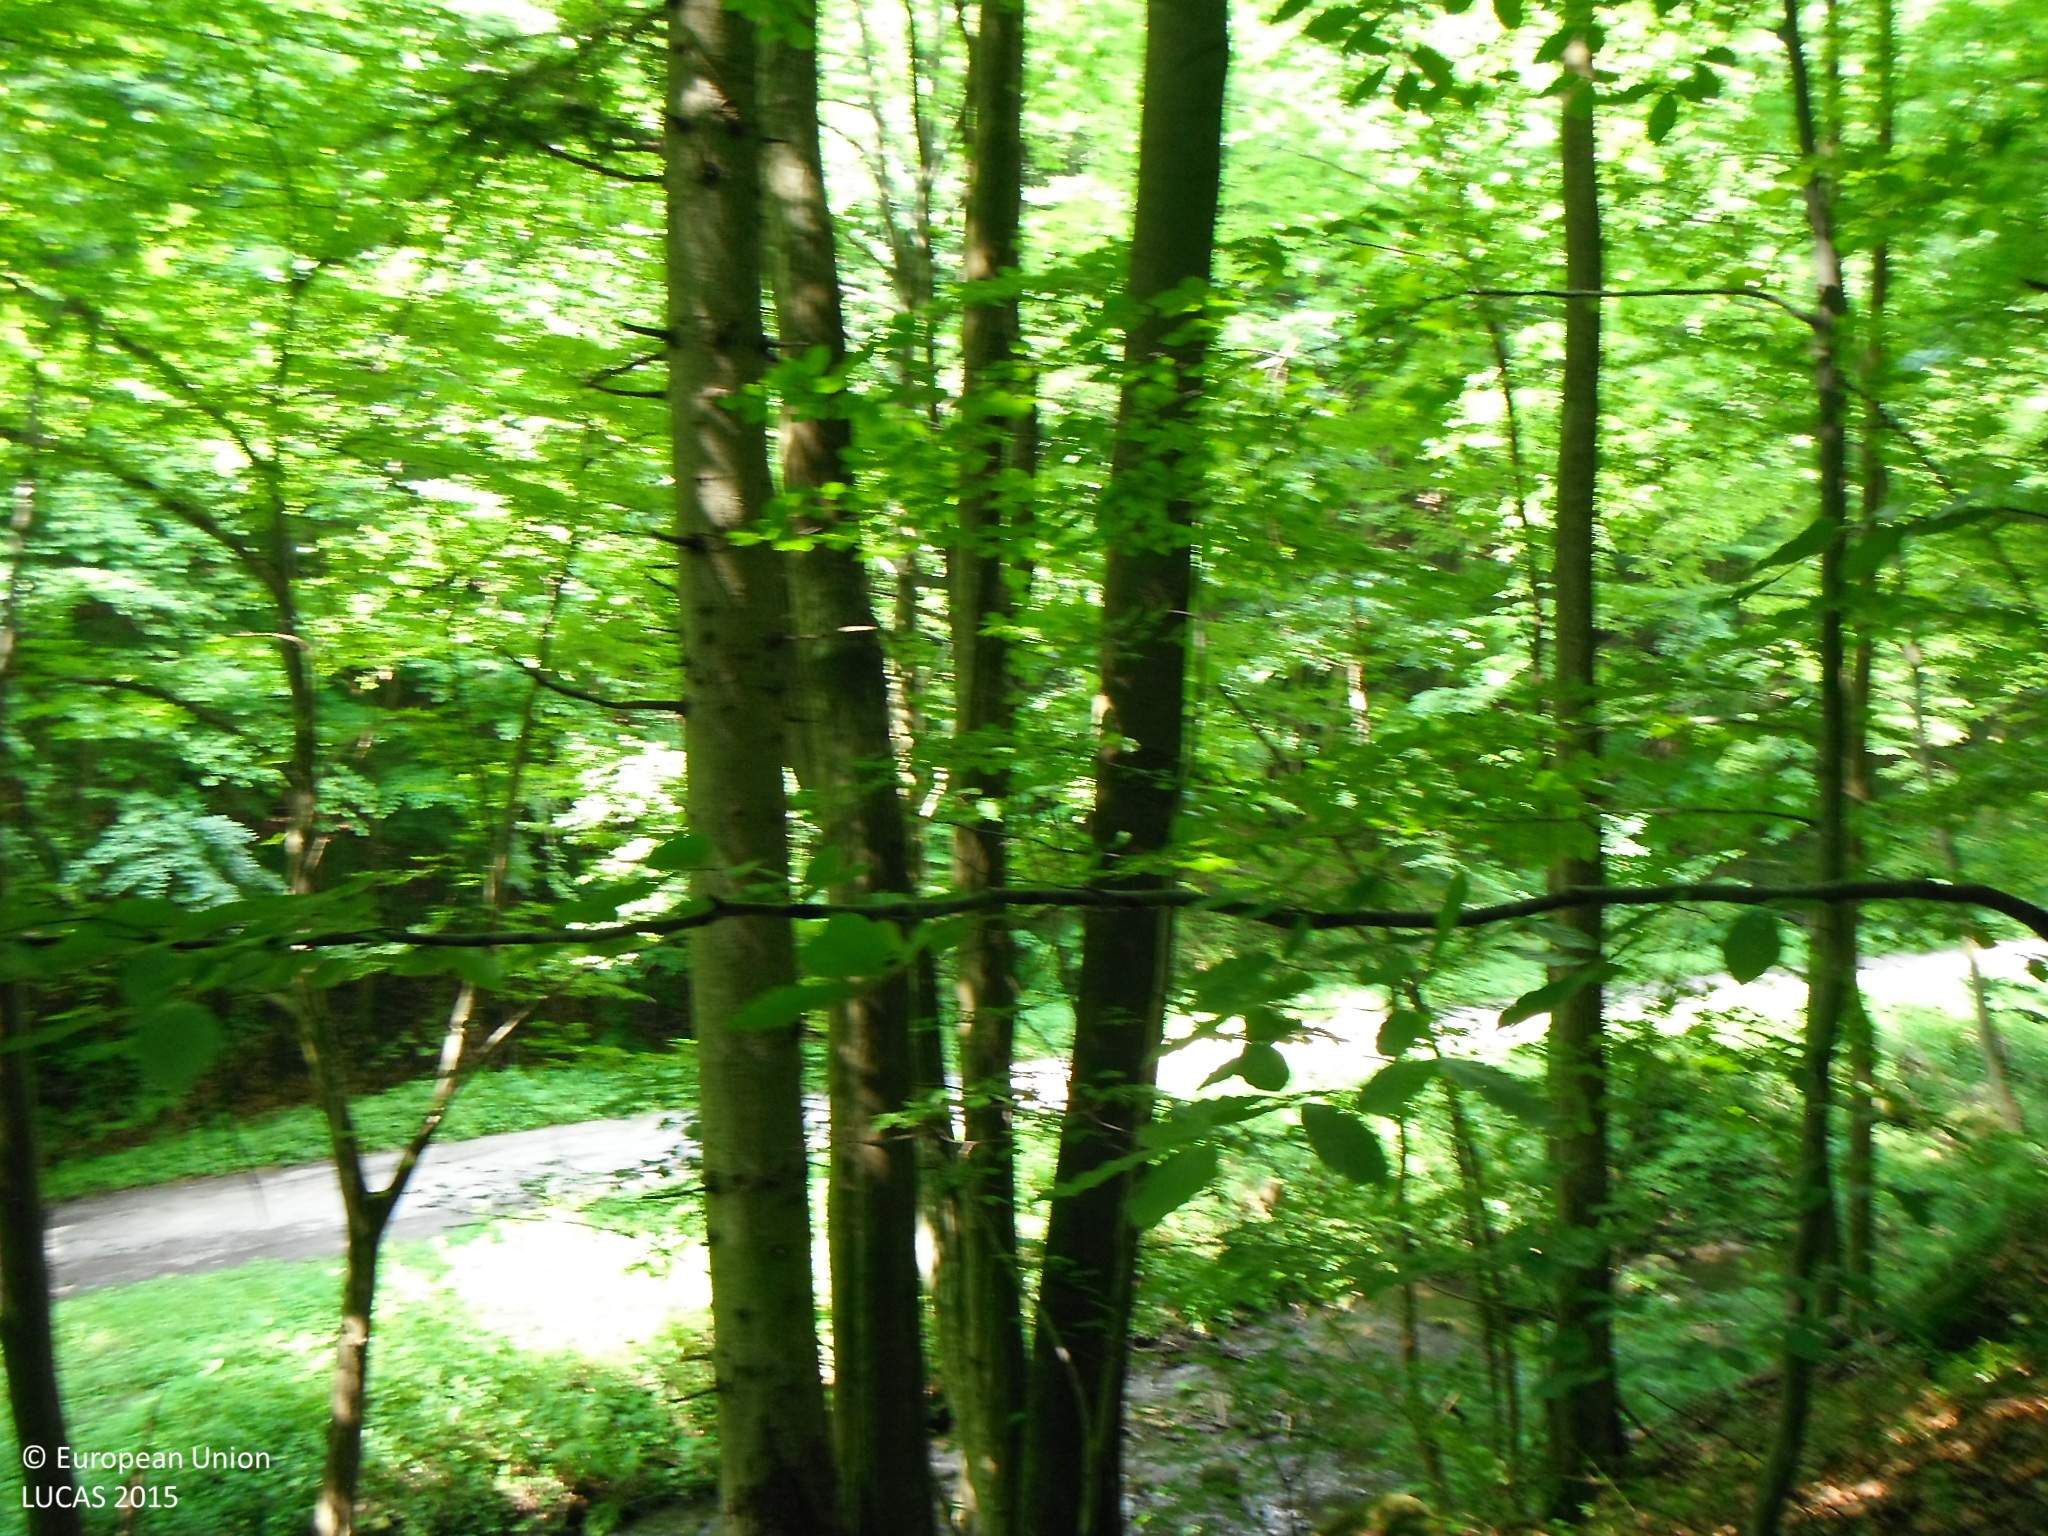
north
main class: Woodland
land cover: Other mixed woodland
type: hemiboreal forest and nemoral coniferous forest and mixed broadleaved-coniferous forest
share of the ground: > 75 %
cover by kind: coniferous forest trees 50 %, broadleaved forest trees 50 %
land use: Forestry
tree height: > 5 m
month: June
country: SK
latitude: 48.6875
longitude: 19.0000
